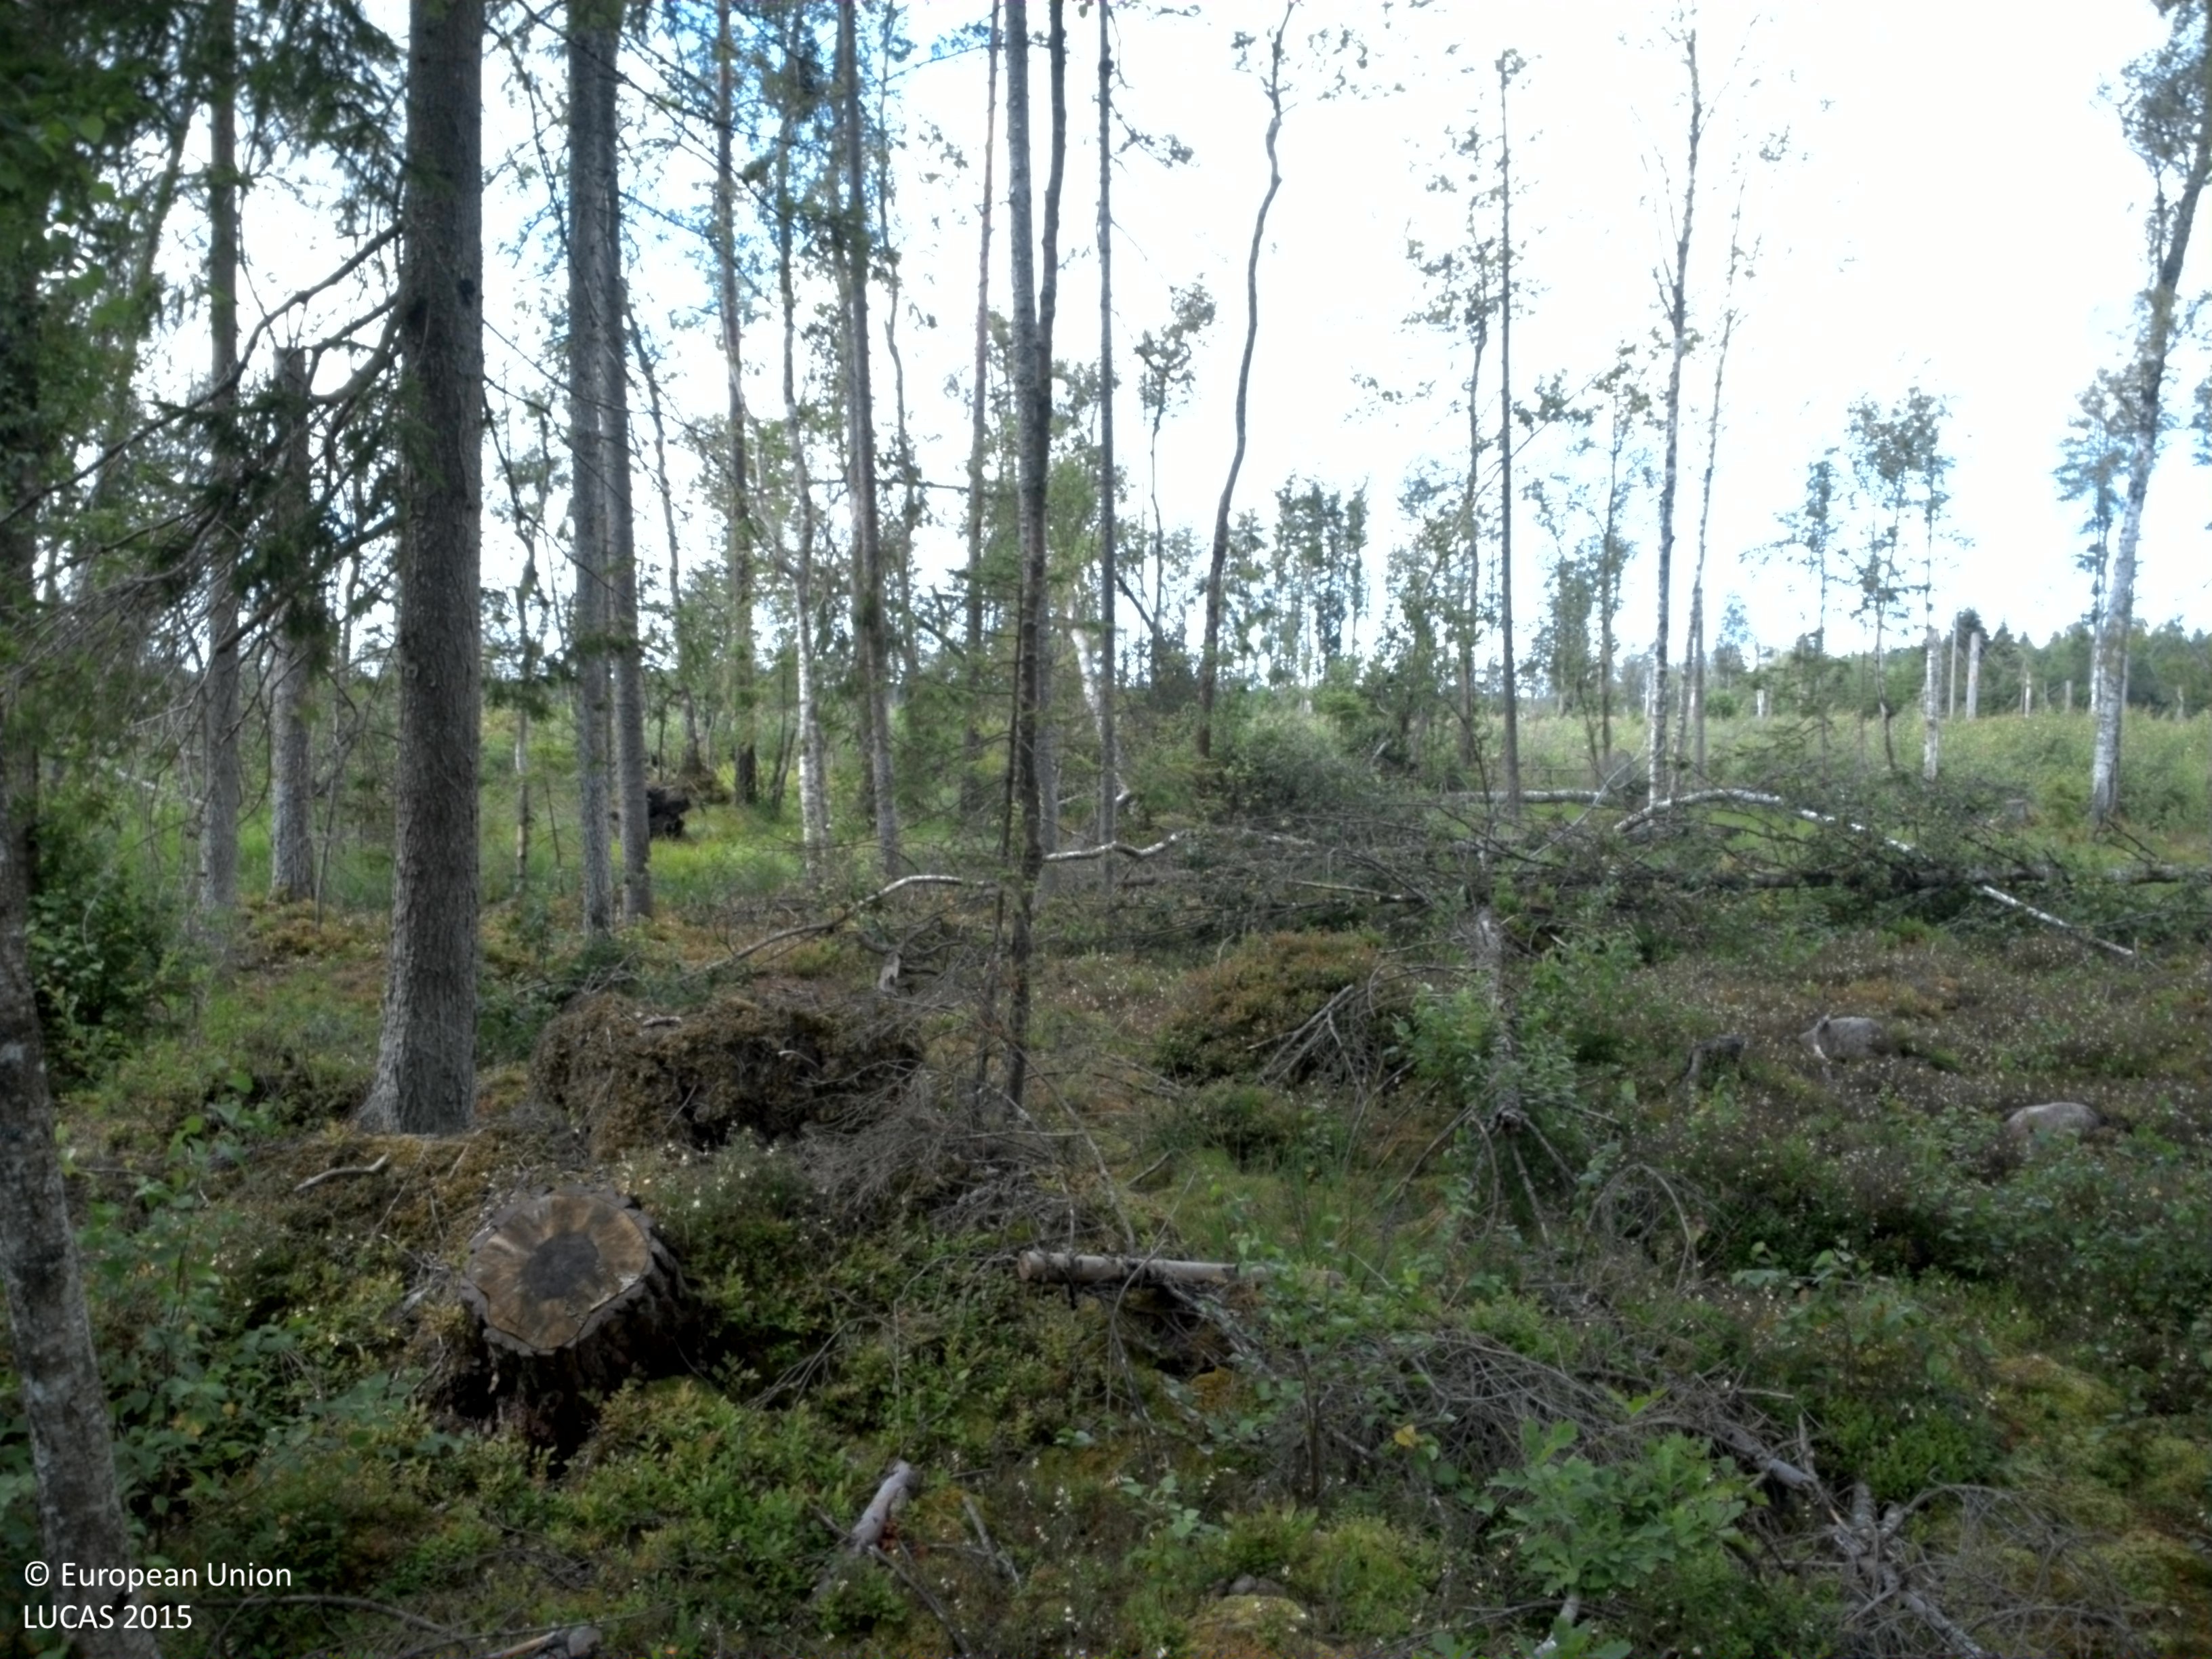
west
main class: Woodland
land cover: Spruce dominated coniferous woodland
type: boreal forest
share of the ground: 10 - 25 %
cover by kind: lichens and mosses 40 %, shrubs 25 %, coniferous forest trees 20 %, unconsolidated bare surface 10 %, broadleaved forest trees 5 %
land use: Forestry
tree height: > 5 m
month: July
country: SE
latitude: 58.7020
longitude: 13.9453
